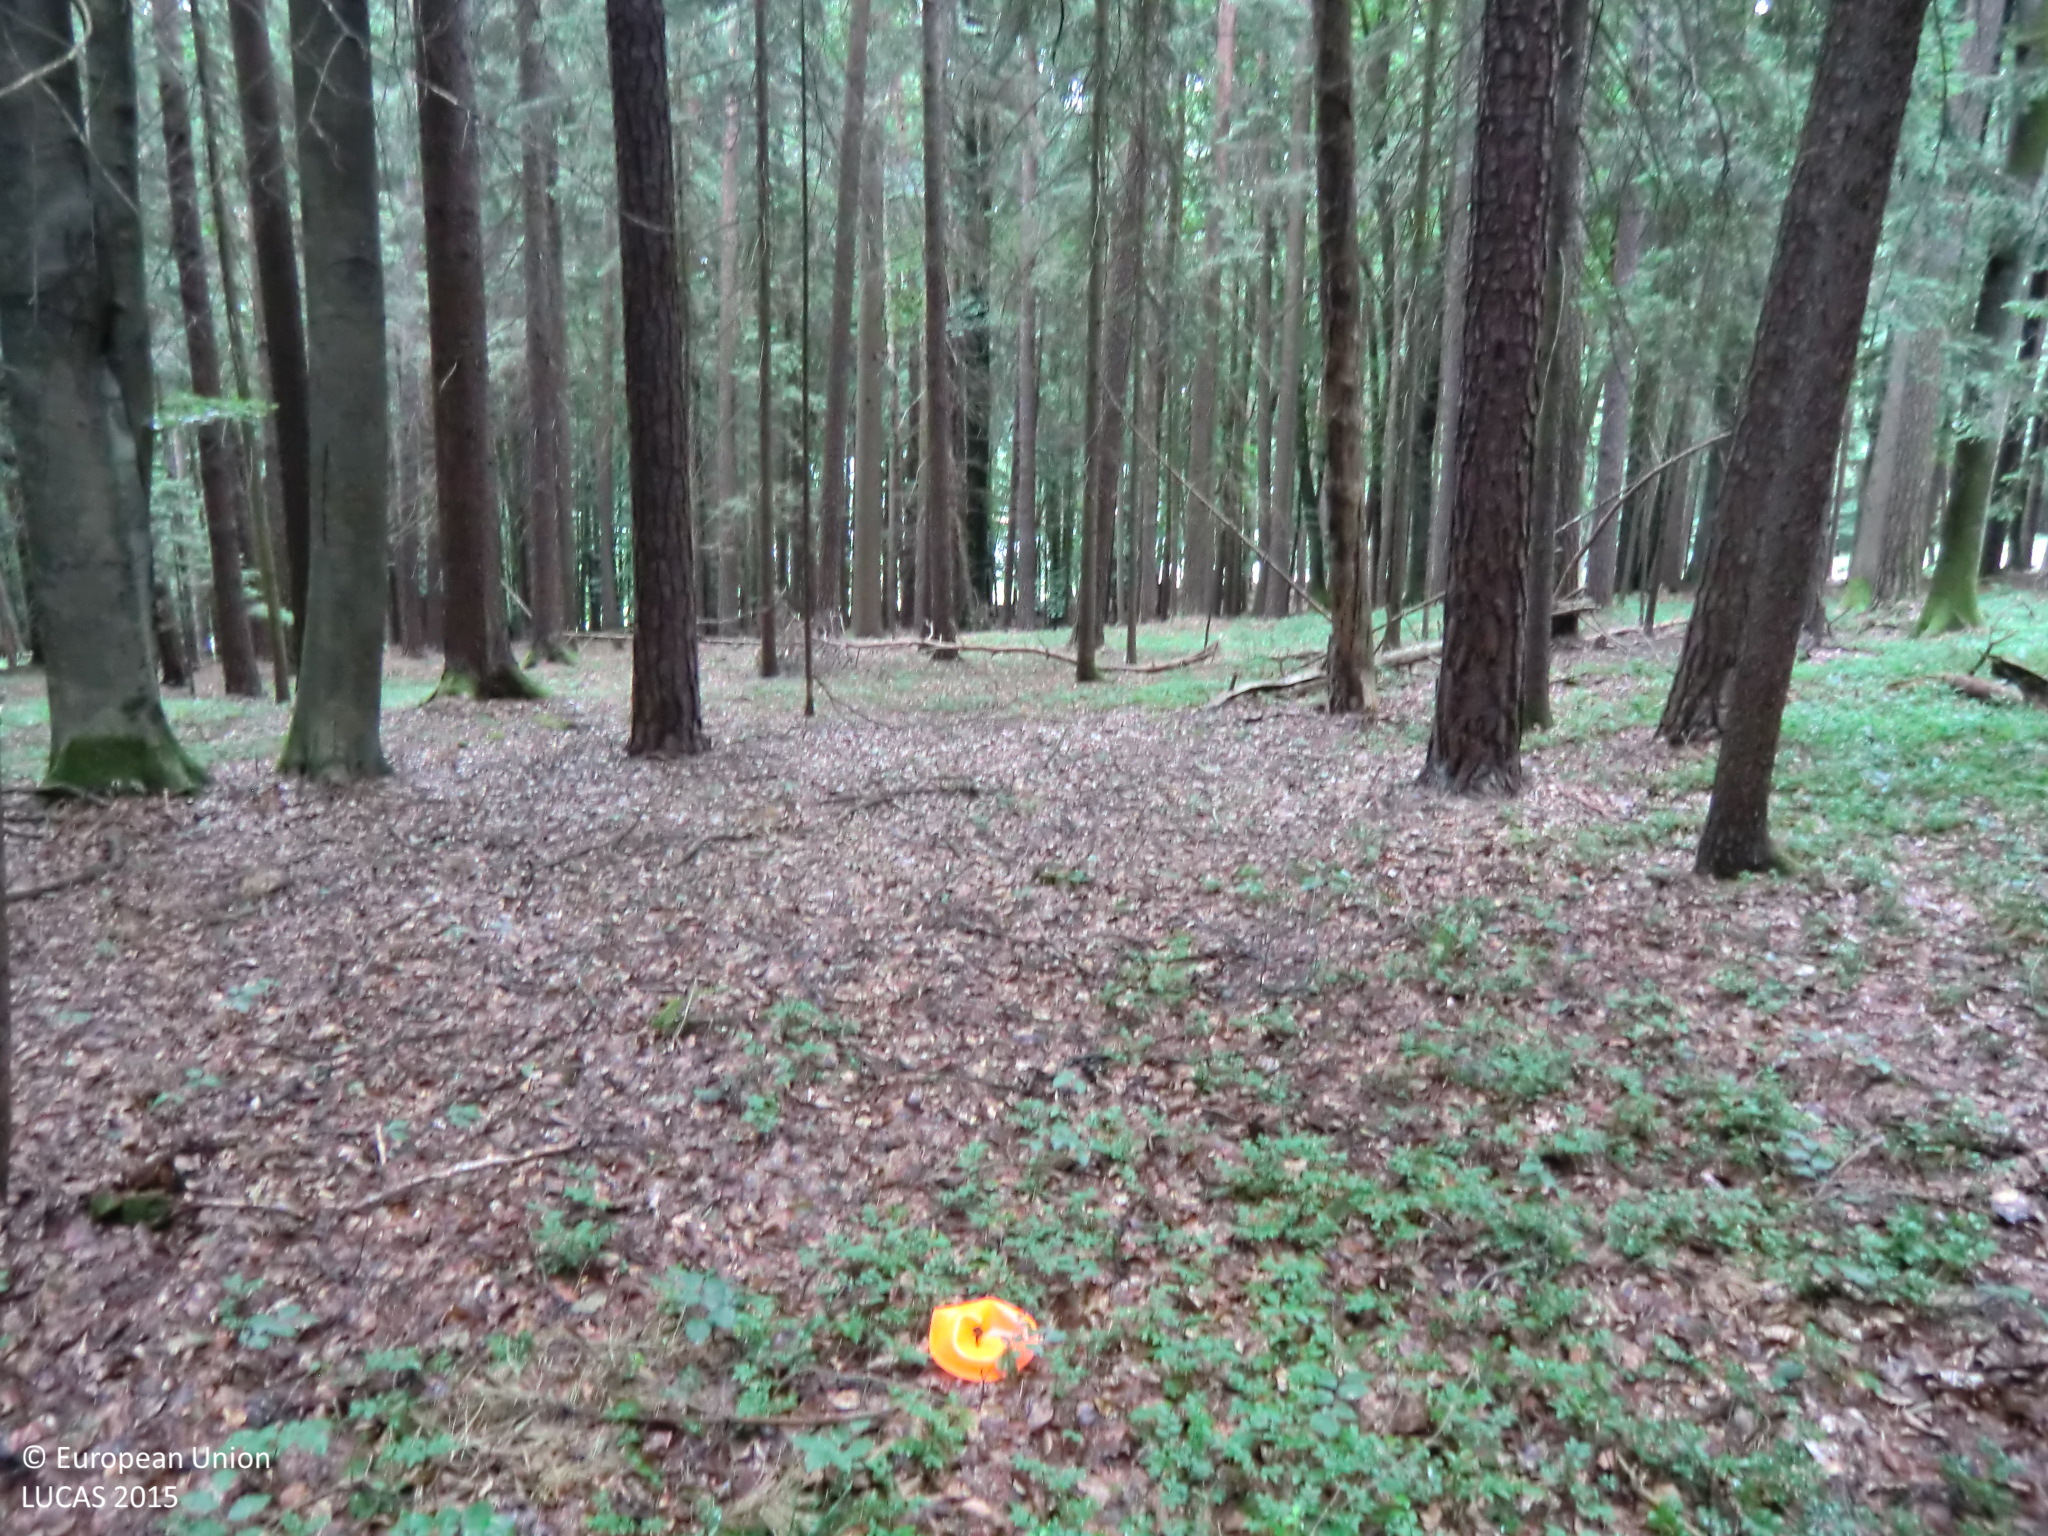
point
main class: Woodland
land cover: Pine dominated mixed woodland
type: hemiboreal forest and nemoral coniferous forest and mixed broadleaved-coniferous forest
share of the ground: > 75 %
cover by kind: coniferous forest trees 40 %, broadleaved forest trees 40 %, shrubs 10 %, unconsolidated bare surface 10 %
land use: Forestry
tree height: > 5 m
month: June
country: AT
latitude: 47.1576
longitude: 16.0028
